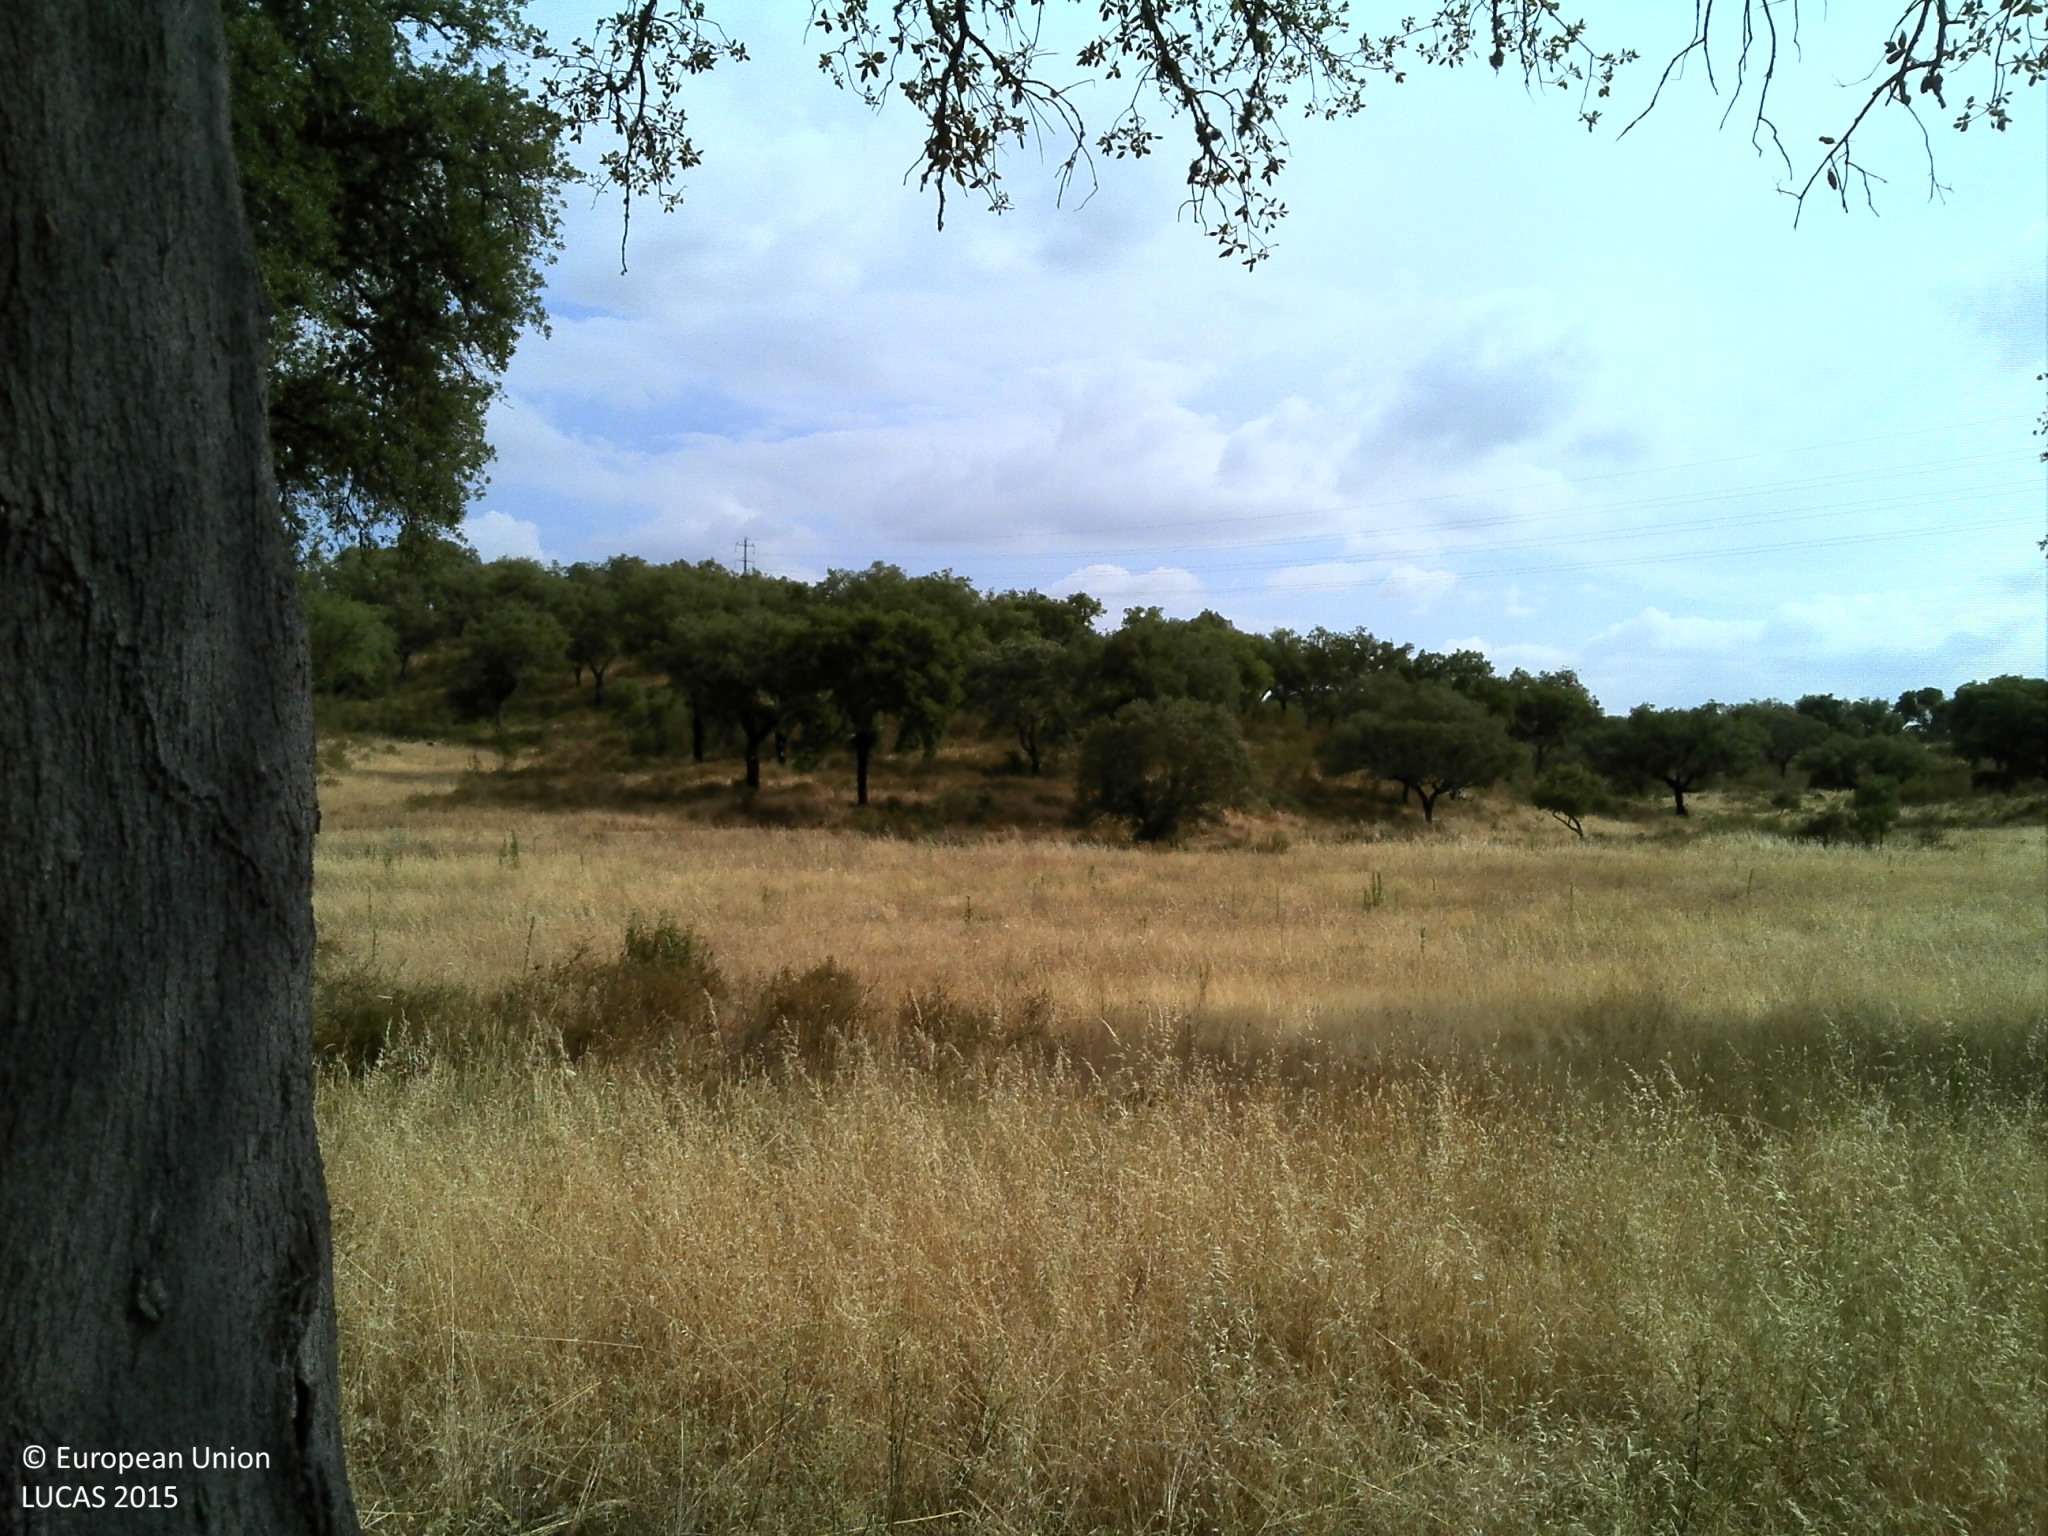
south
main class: Woodland
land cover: Broadleaved woodland
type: broadleaved evergreen forest
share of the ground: 25 - 50 %
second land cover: Grassland without tree/shrub cover
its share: 25 - 50 %
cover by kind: unconsolidated bare surface 35 %, herbaceous plants 30 %, broadleaved forest trees 25 %, shrubs 10 %
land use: Forestry
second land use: Agriculture (excluding fallow land and kitchen gardens)
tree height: > 5 m
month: June
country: PT
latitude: 38.3864
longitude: -7.7896
